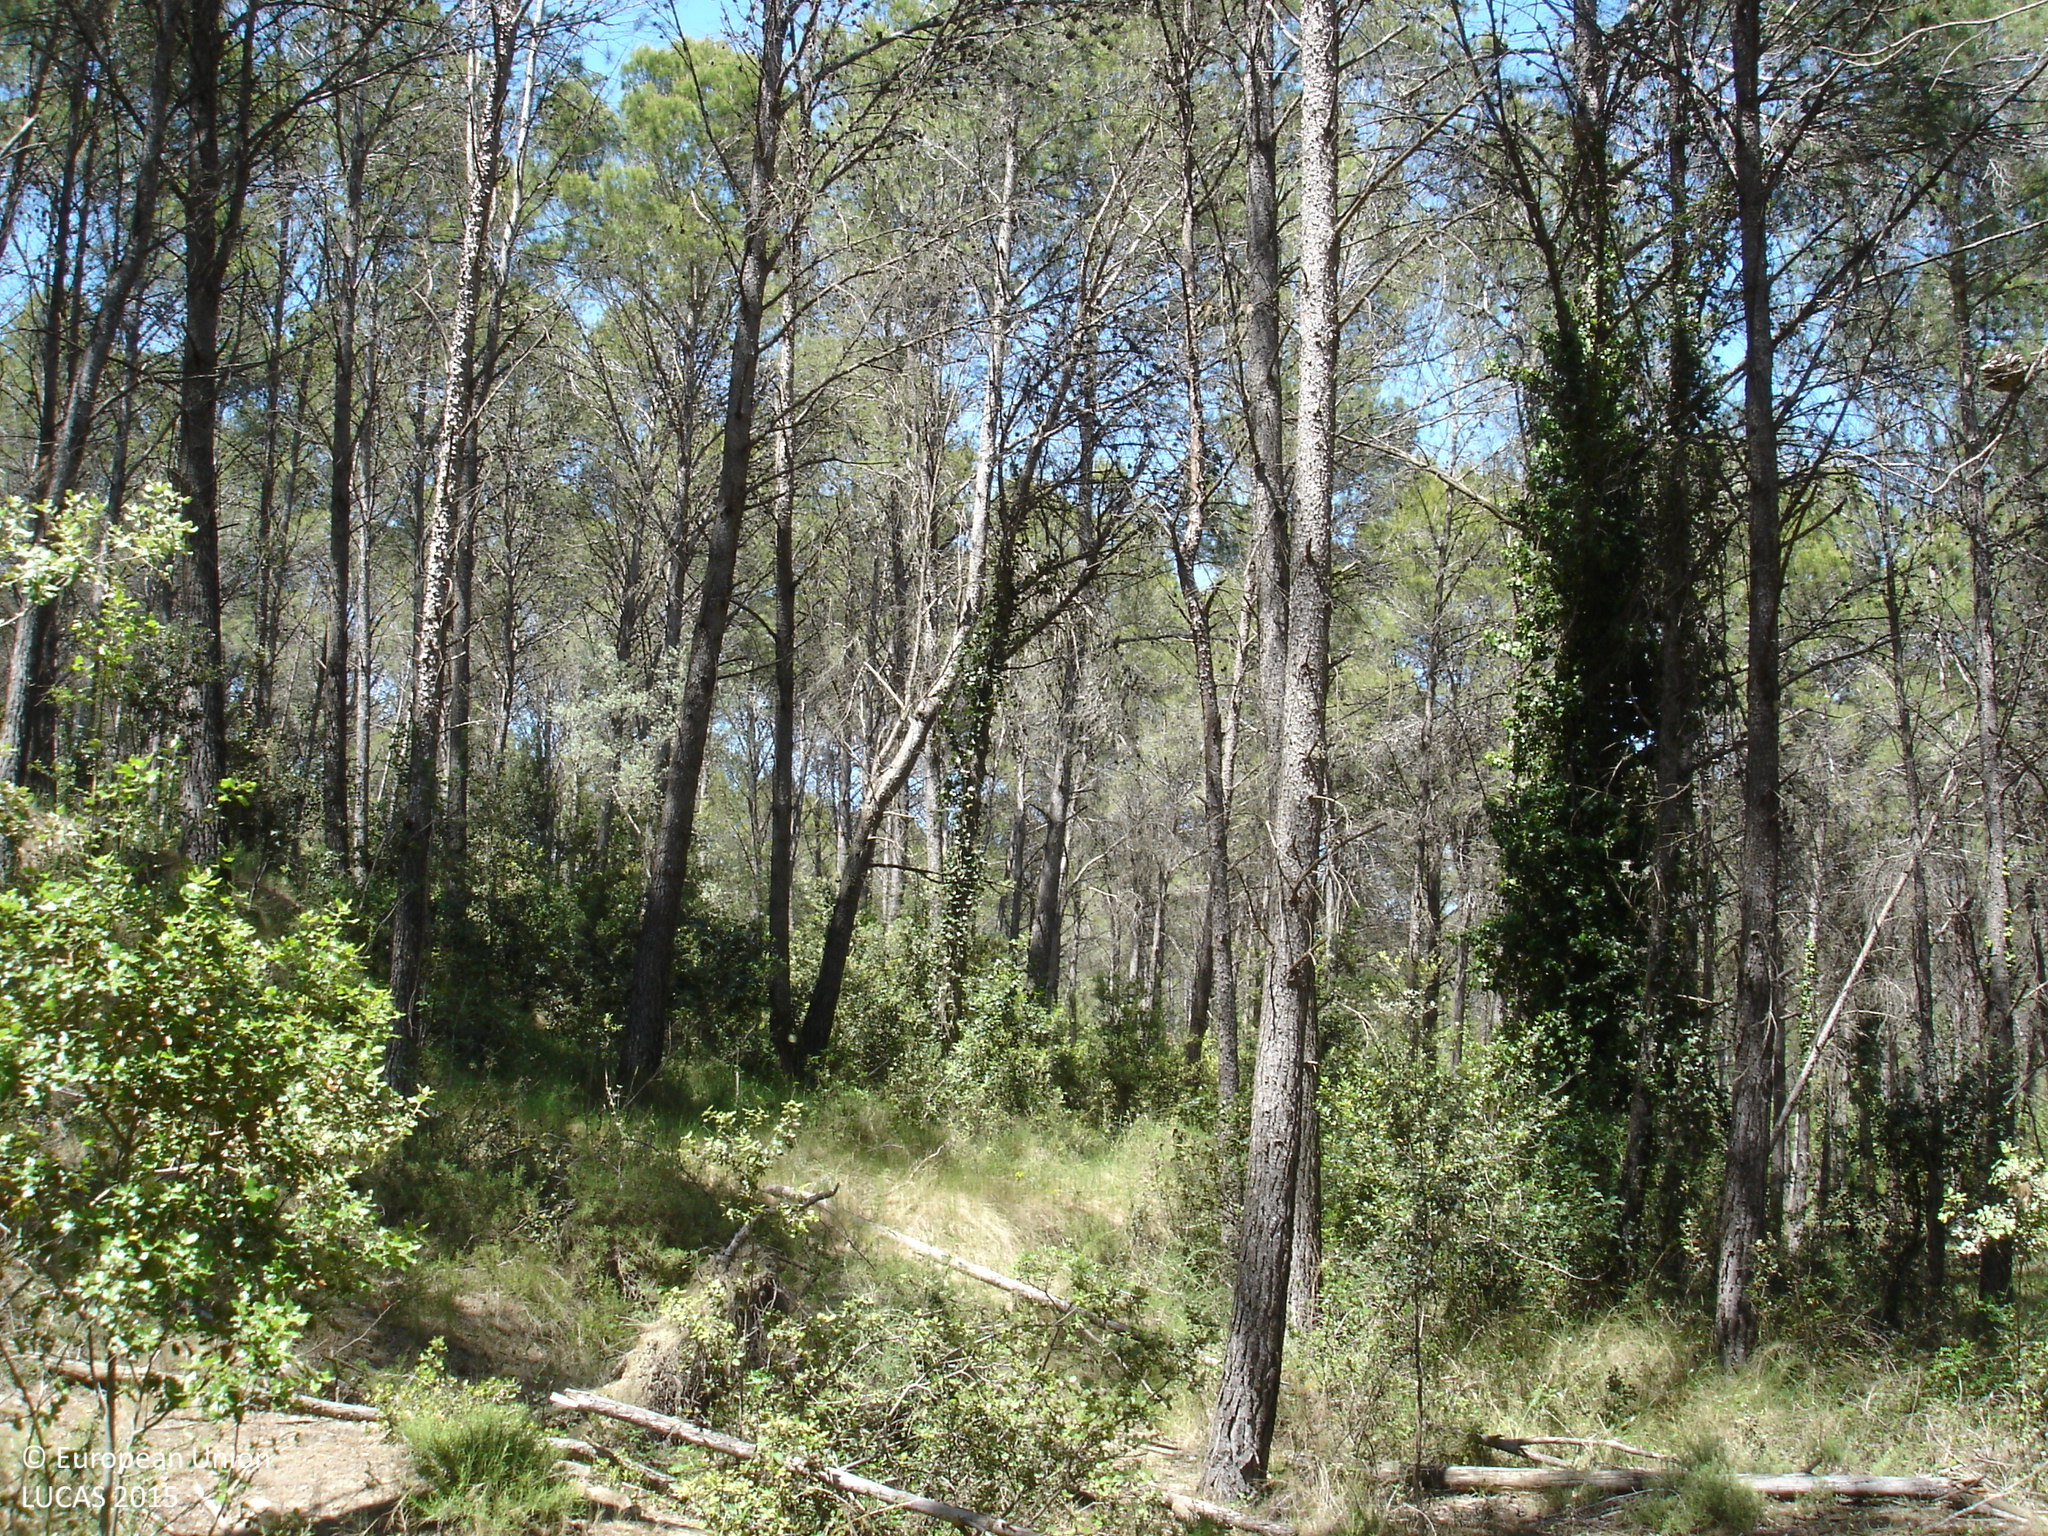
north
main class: Woodland
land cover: Pine dominated coniferous woodland
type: coniferous forest of the mediterranean region
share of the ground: > 75 %
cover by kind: coniferous forest trees 80 %, herbaceous plants 10 %, broadleaved forest trees 5 %, shrubs 5 %
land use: Forestry
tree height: > 5 m
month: May
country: ES
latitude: 42.0865
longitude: 3.0156
